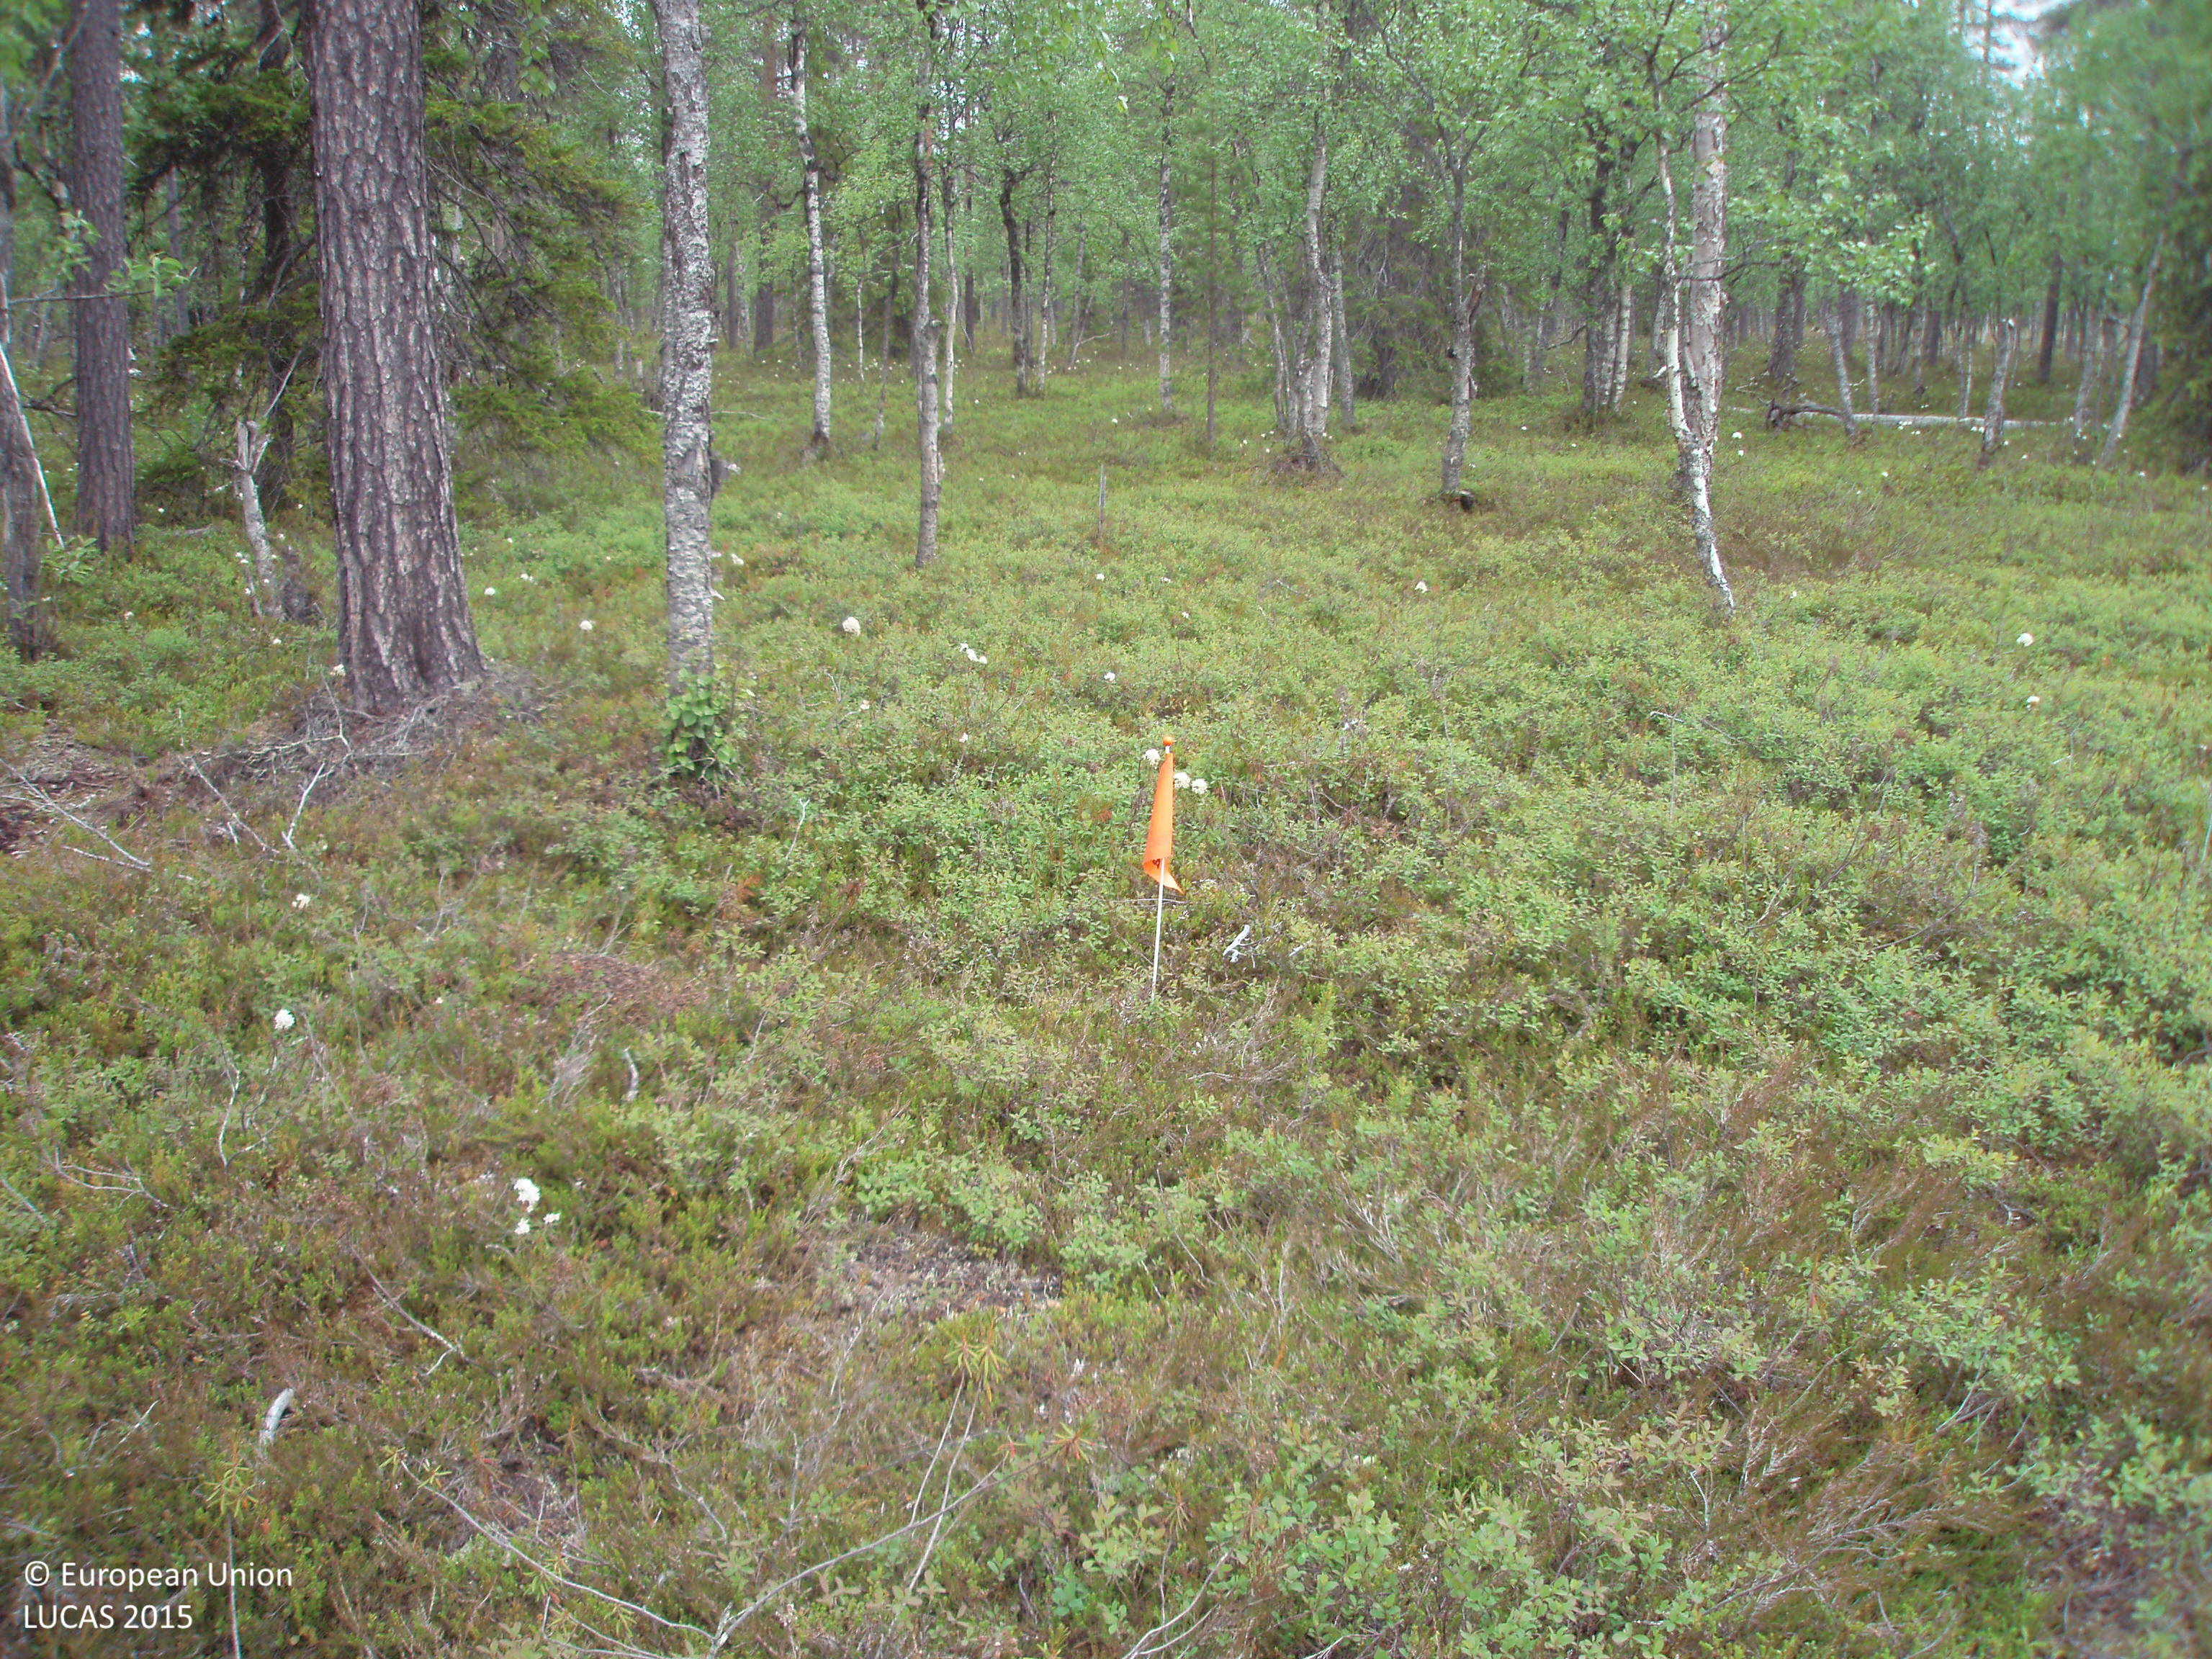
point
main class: Woodland
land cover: Pine dominated mixed woodland
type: boreal forest
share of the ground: 25 - 50 %
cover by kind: shrubs 60 %, coniferous forest trees 20 %, broadleaved forest trees 20 %
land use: Forestry
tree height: > 5 m
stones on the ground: 10 - 25 %
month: July
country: FI
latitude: 67.6828
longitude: 28.6060
